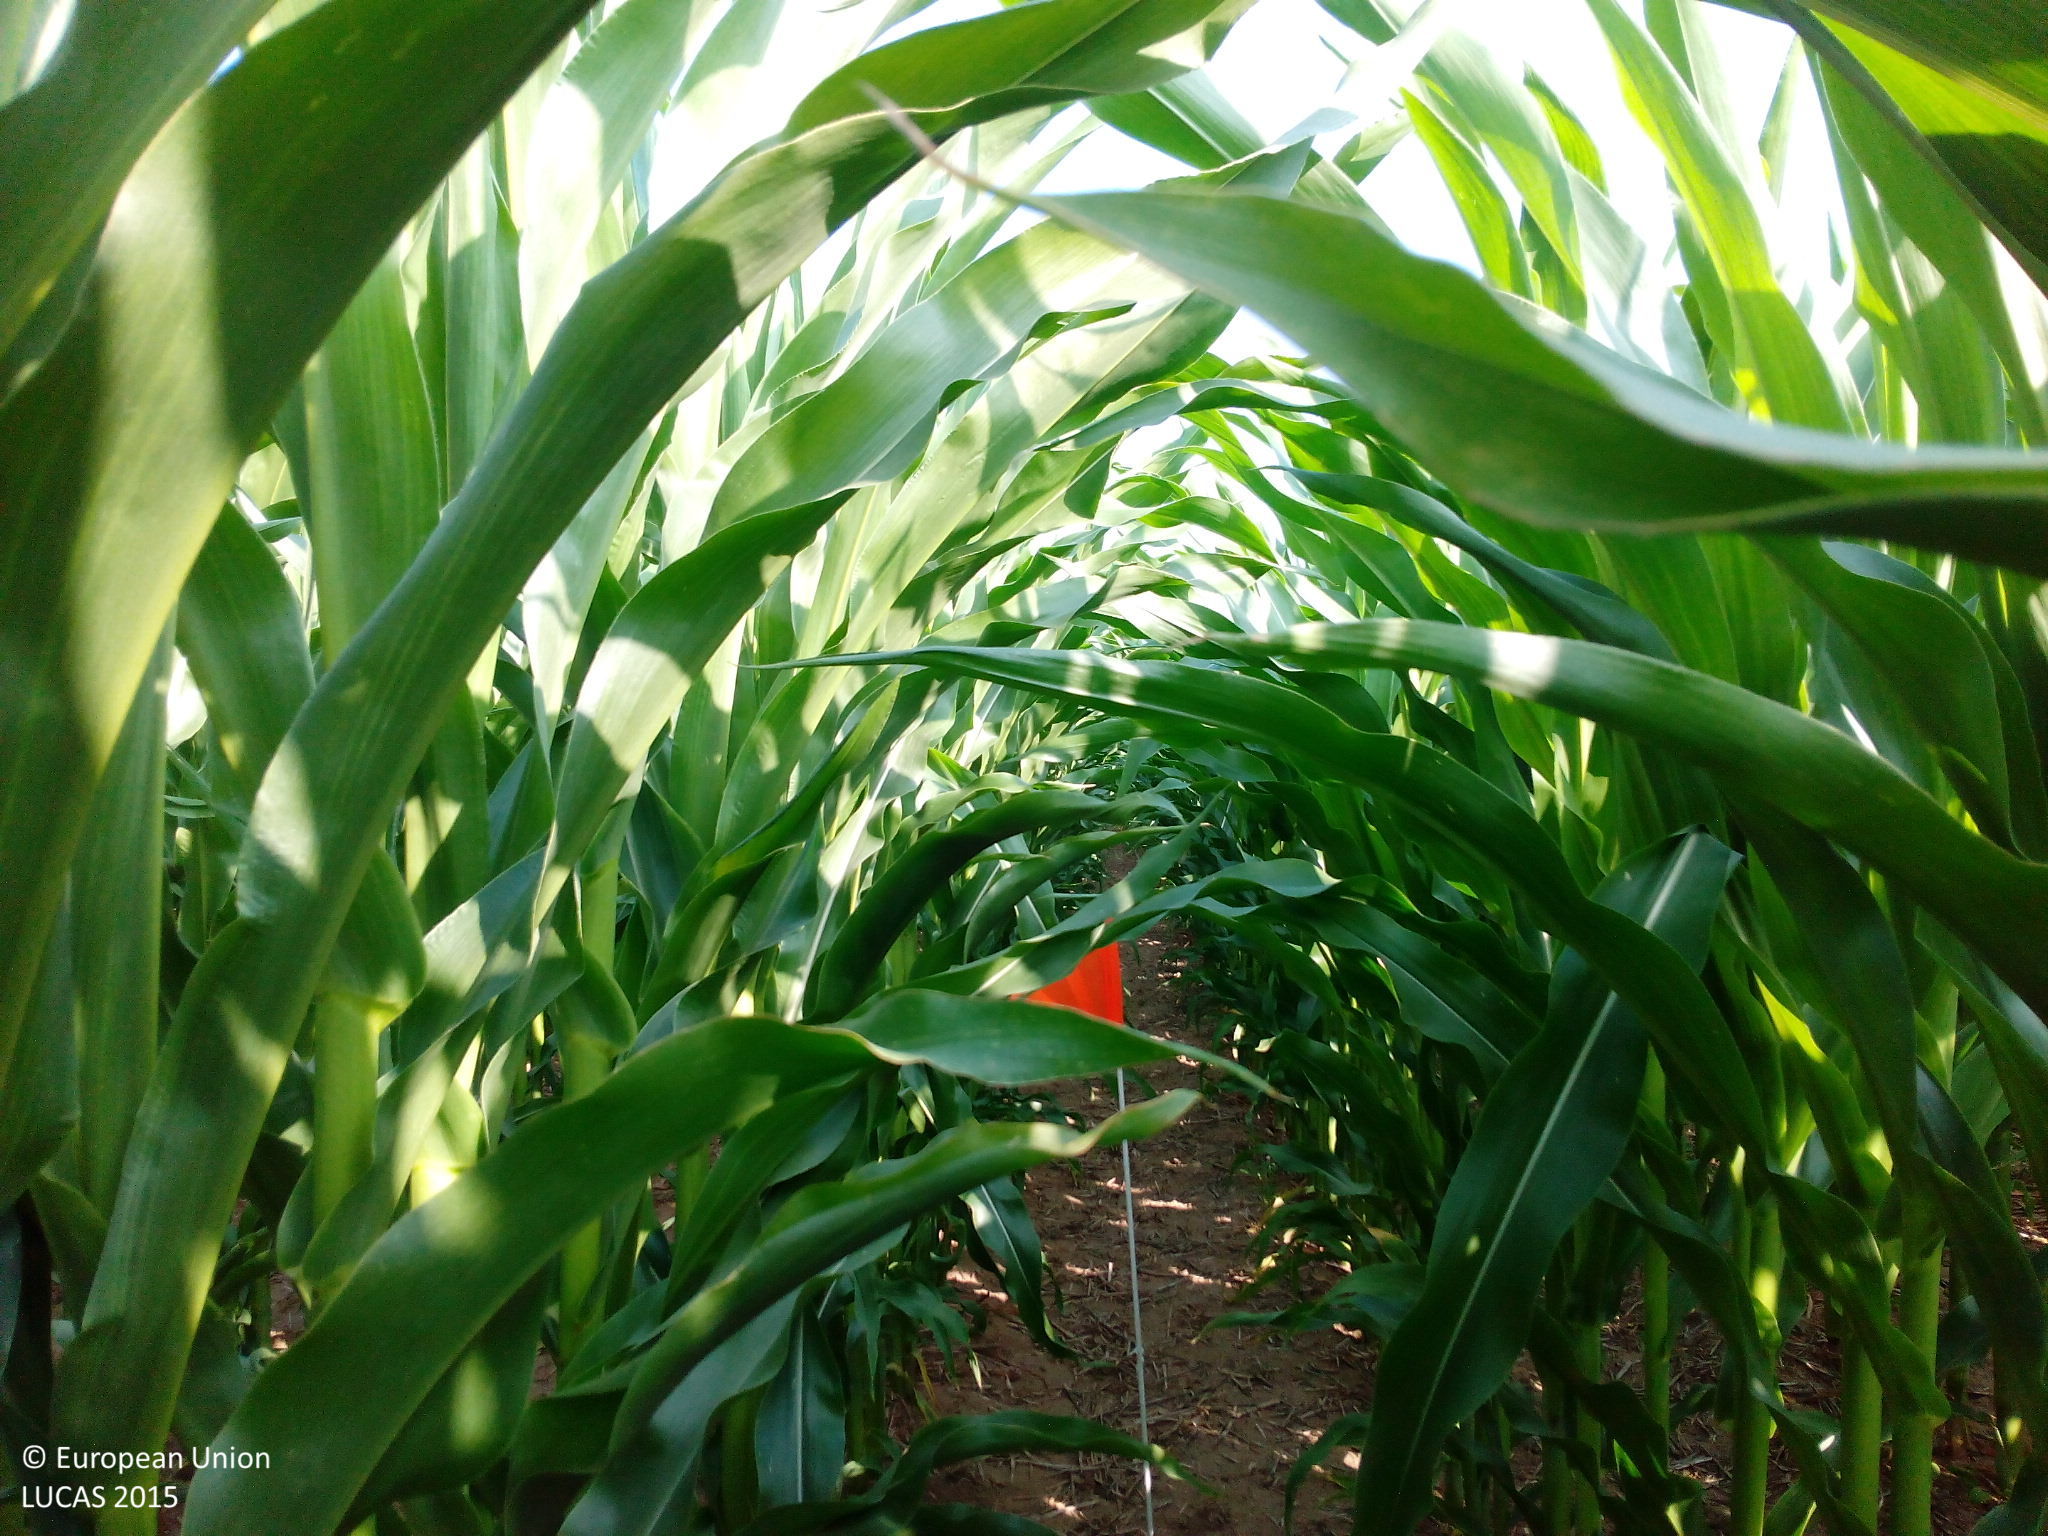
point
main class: Cropland
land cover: Maize
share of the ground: > 75 %
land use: Agriculture (excluding fallow land and kitchen gardens)
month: July
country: DE
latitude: 49.8385
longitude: 10.9591
